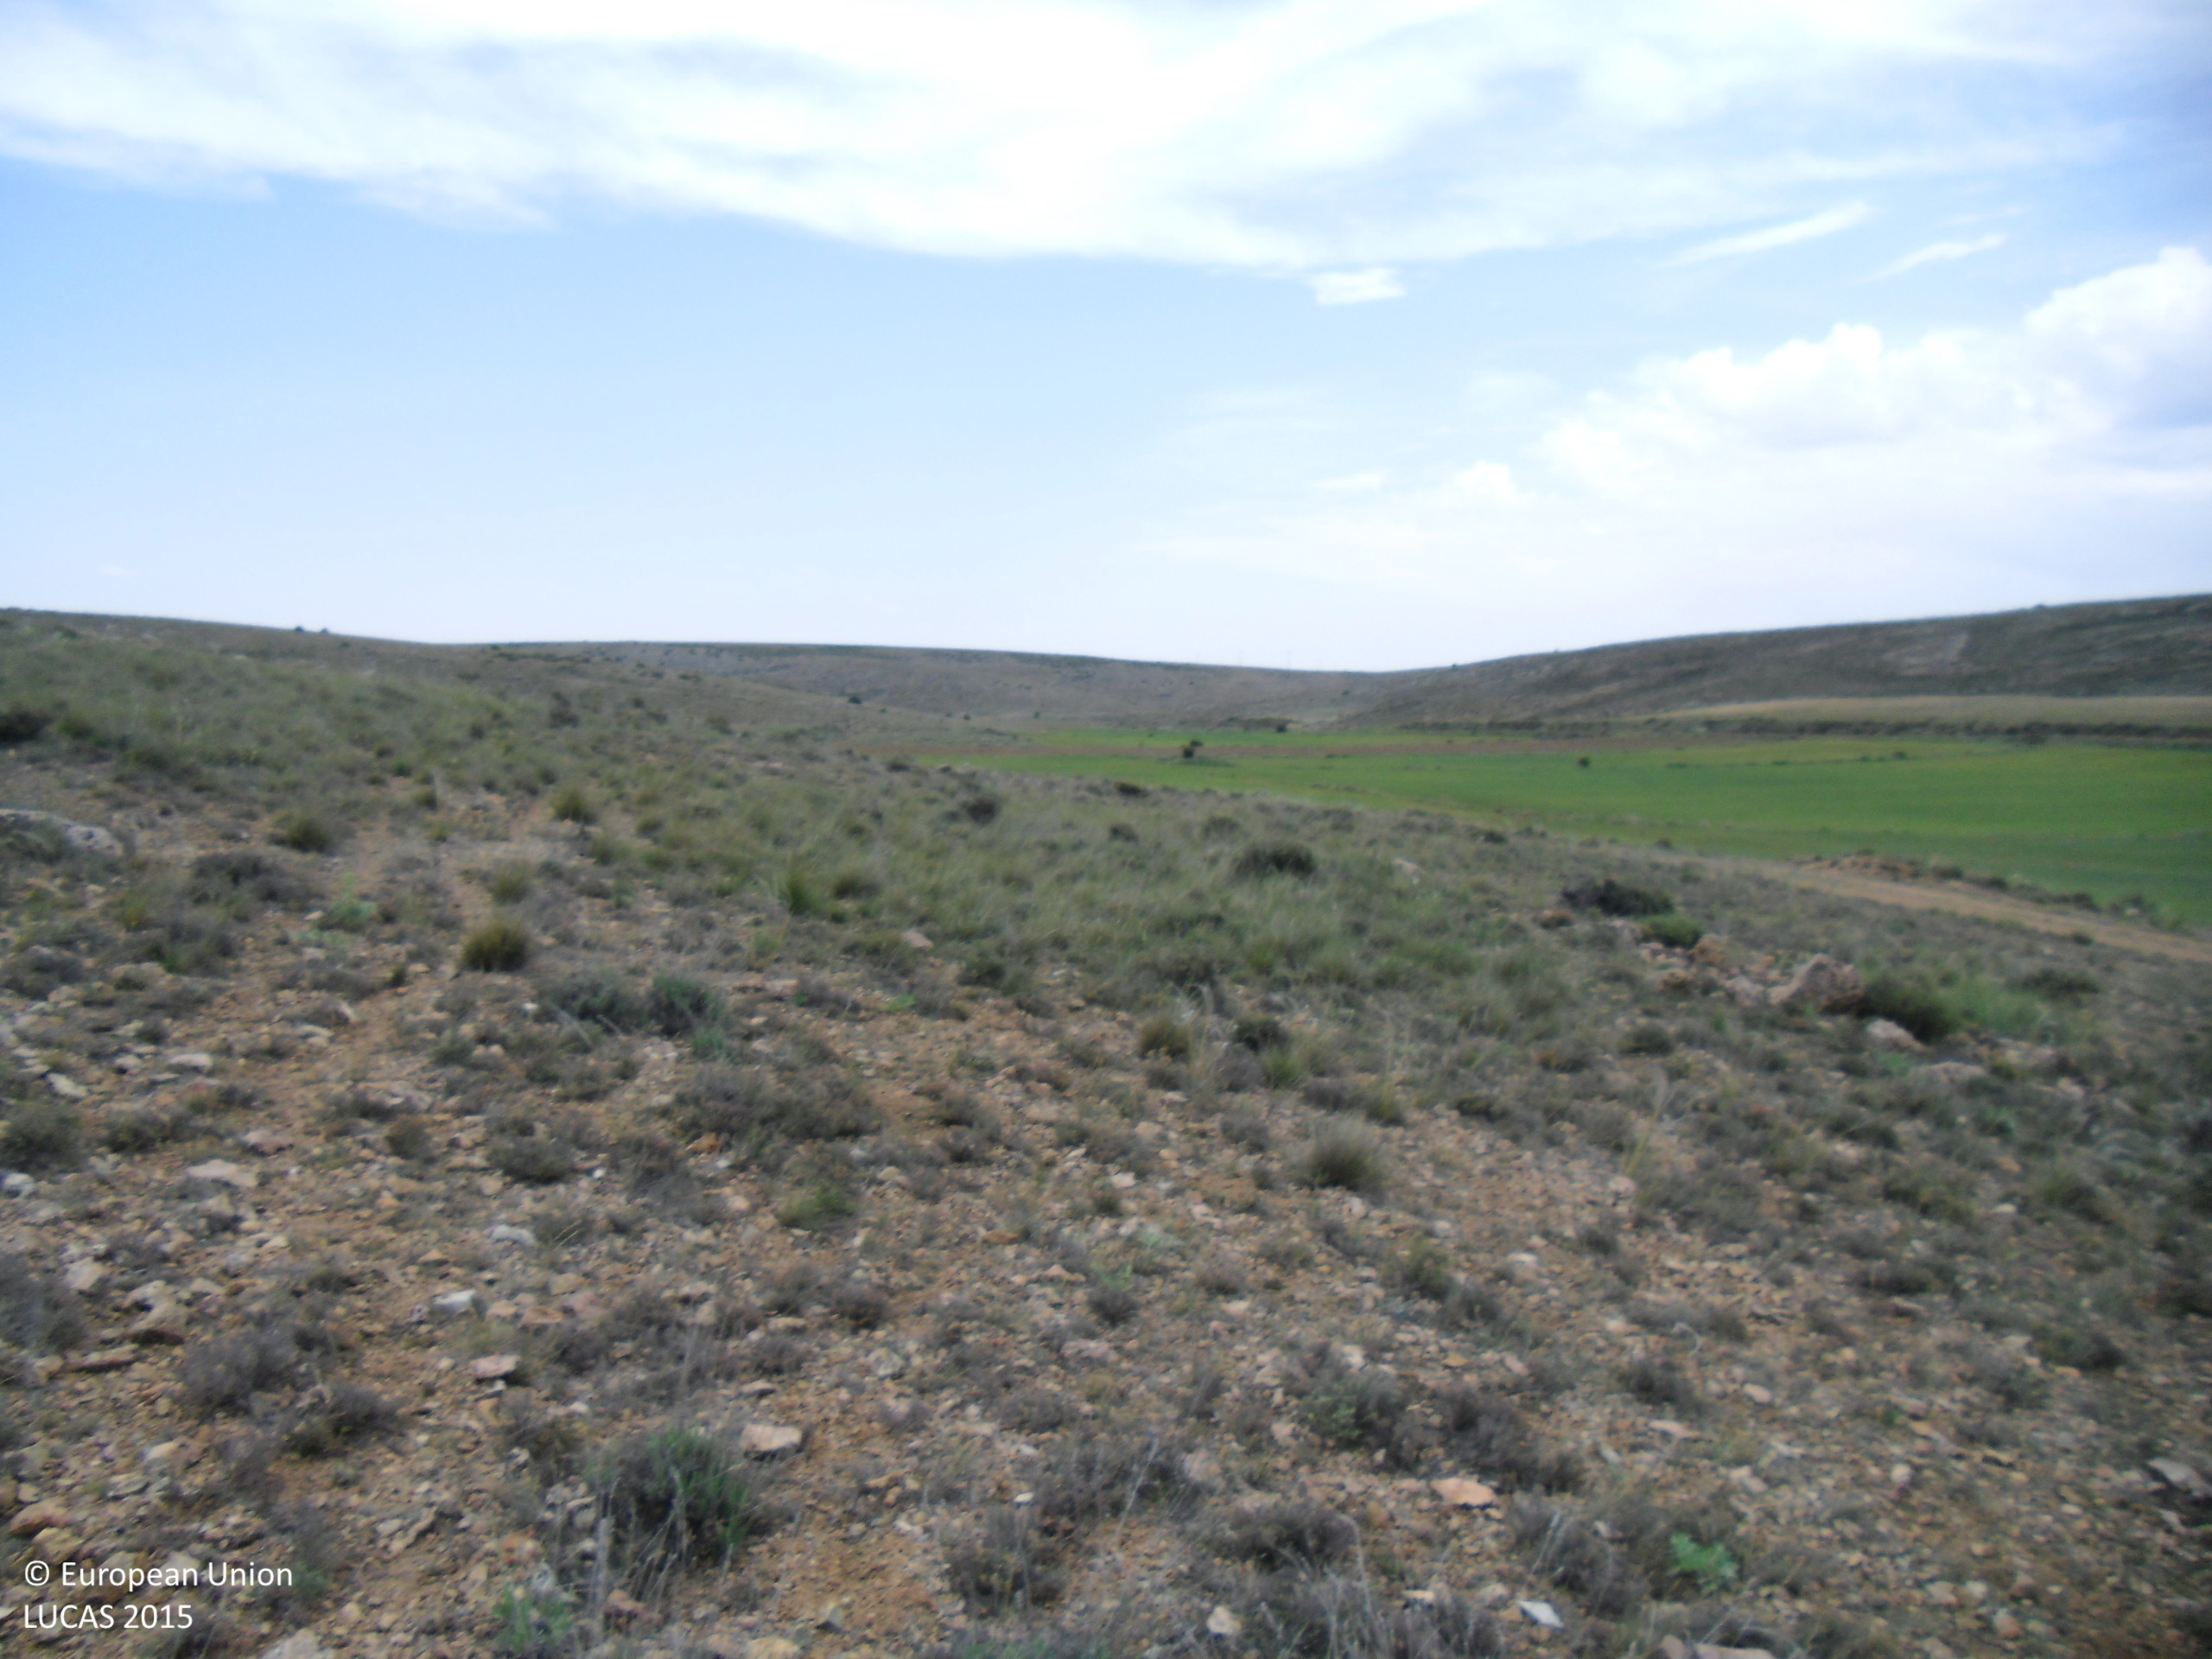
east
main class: Shrubland
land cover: Shrubland without tree cover
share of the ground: 10 - 25 %
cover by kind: consolidated bare surface 60 %, shrubs 20 %, herbaceous plants 20 %
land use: Agriculture (excluding fallow land and kitchen gardens)
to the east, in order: Shrubland without tree cover; Tracks; Shrubland without tree cover; Barley; Grass margins; Barley; Grass margins; Barley; Grass margins; Barley; Grass margins; Tracks; Shruby margins; Spontaneously vegetated surfaces
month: May
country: ES
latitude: 40.9723
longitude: -0.8888
